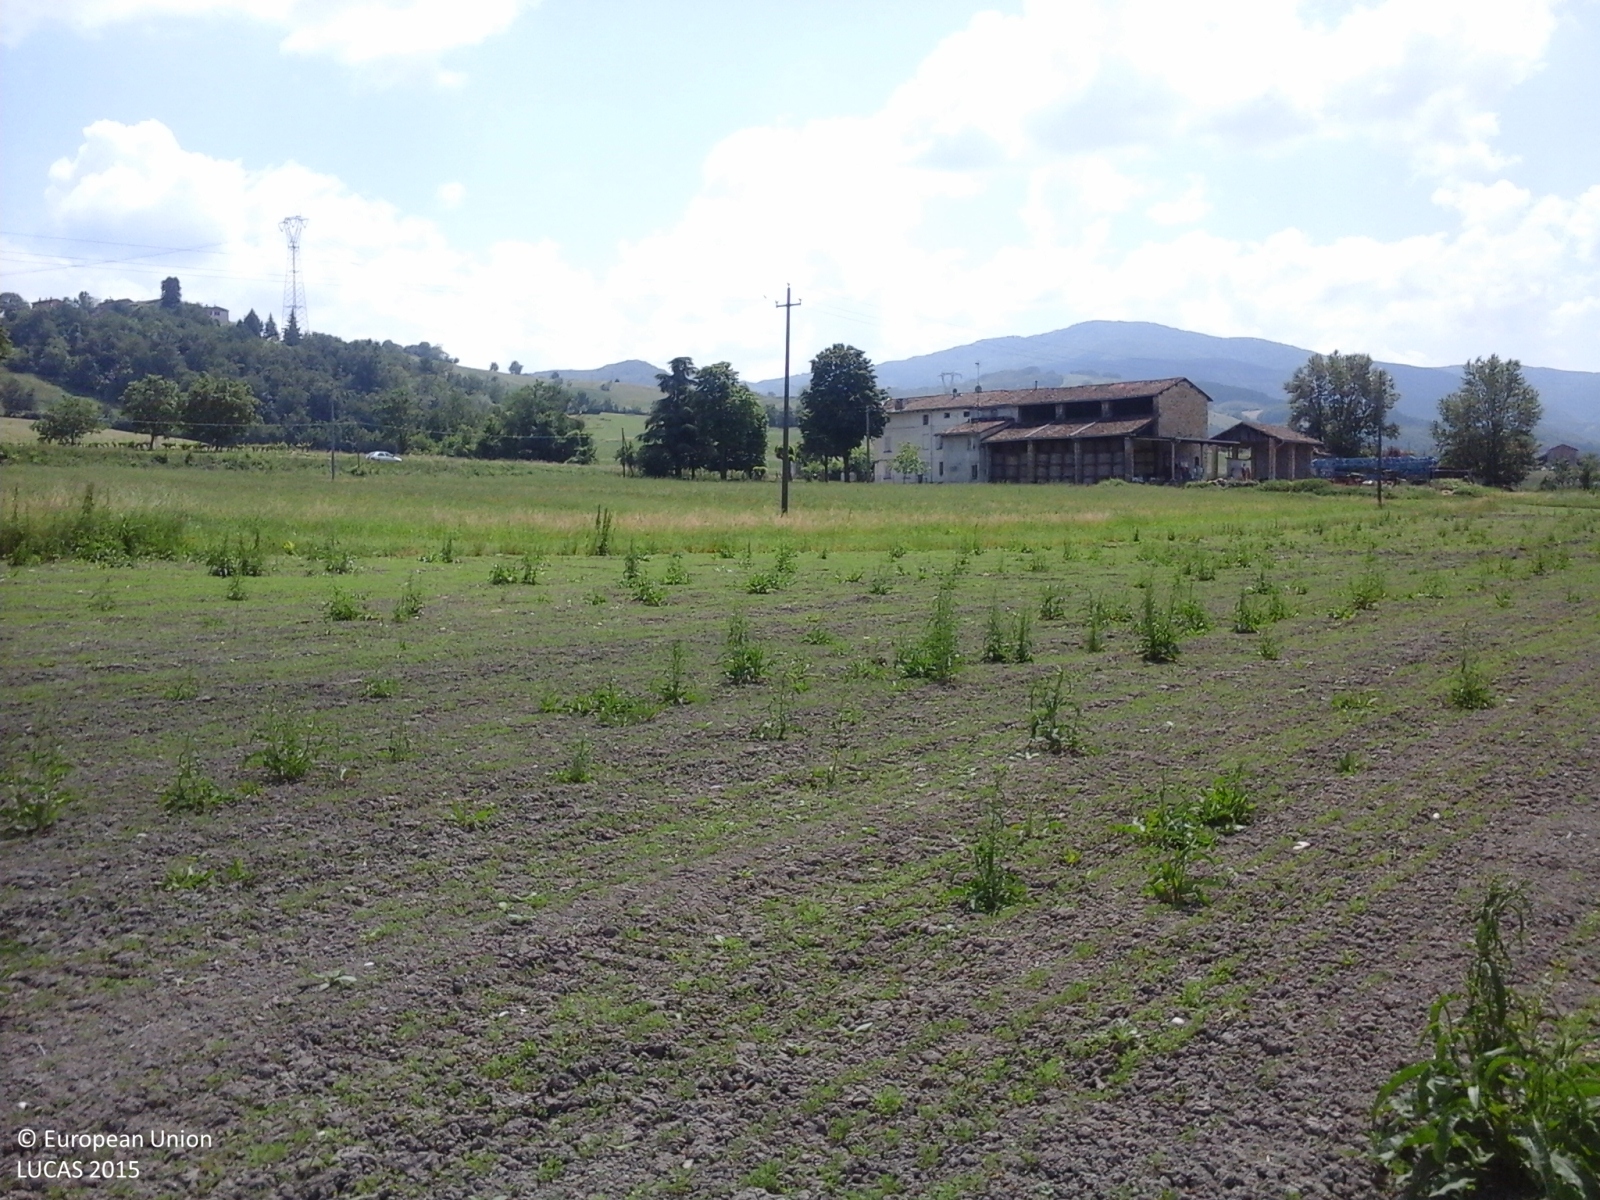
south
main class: Cropland
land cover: Lucerne
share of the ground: < 10 %
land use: Agriculture (excluding fallow land and kitchen gardens)
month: May
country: IT
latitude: 44.6570
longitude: 10.1888
